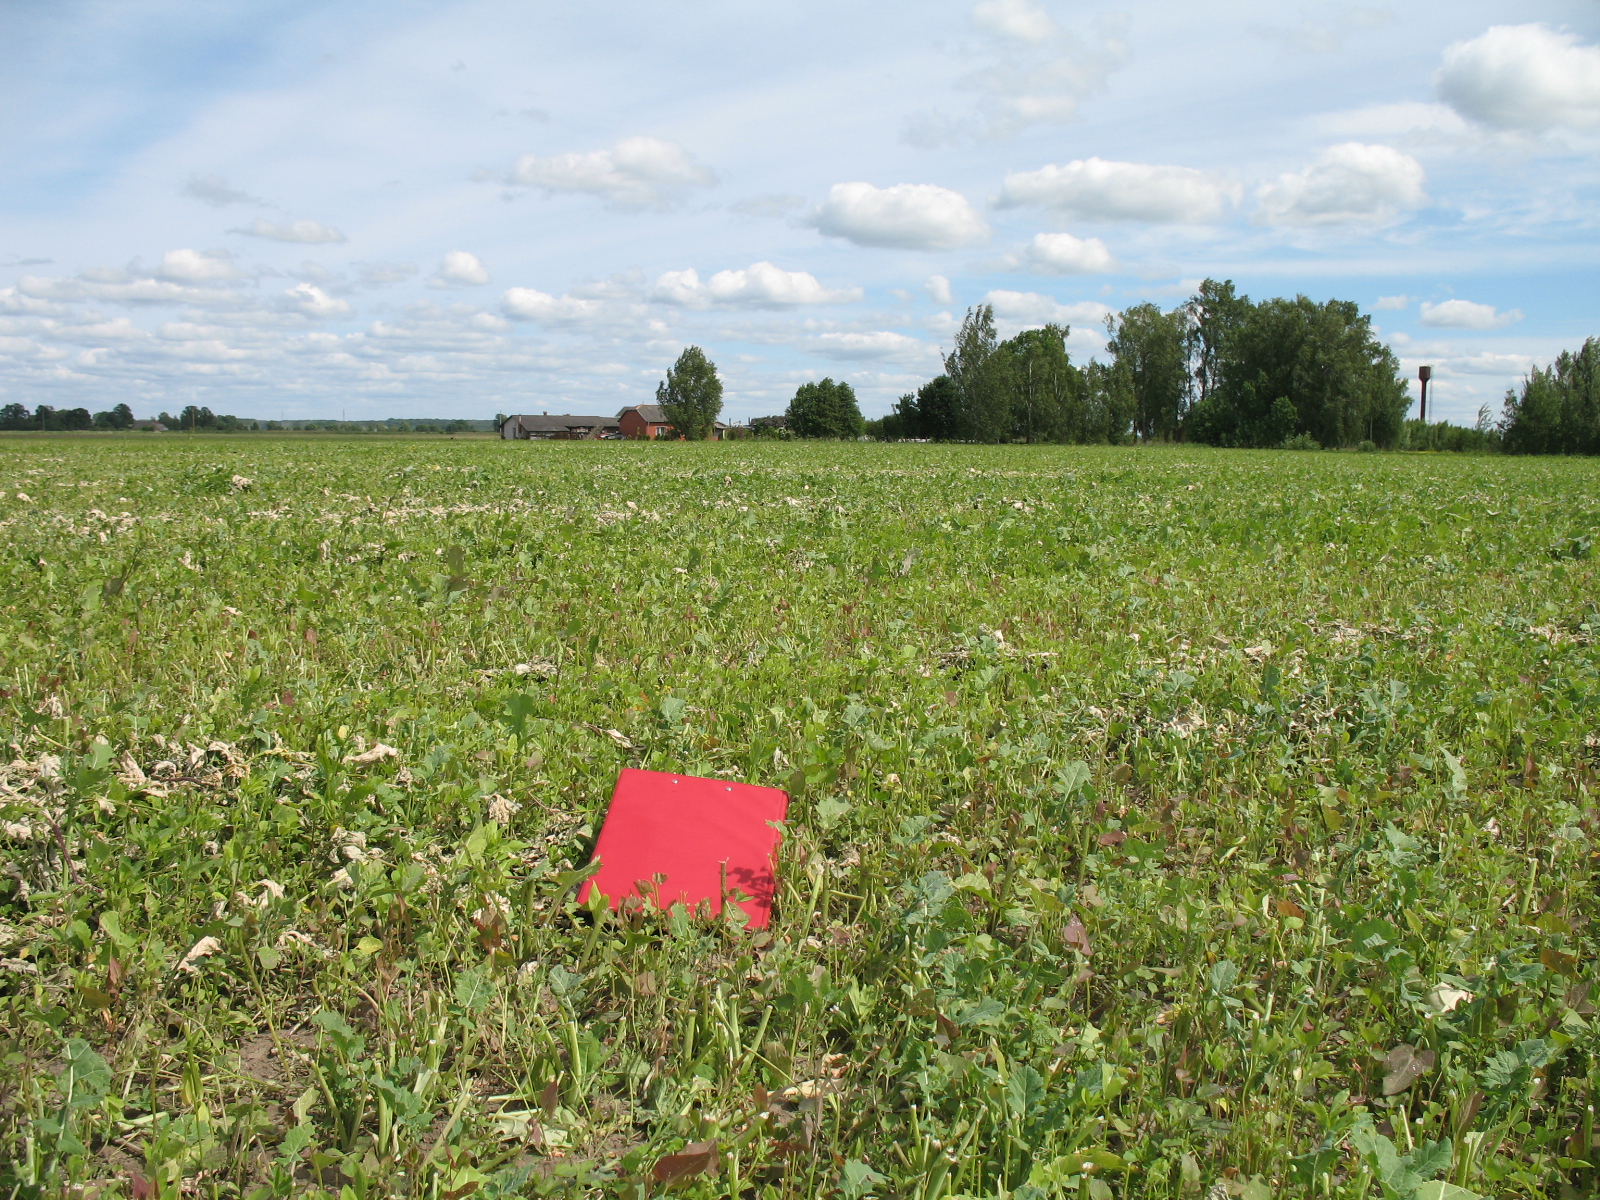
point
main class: Cropland
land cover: Rape and turnip rape
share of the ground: > 75 %
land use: Agriculture (excluding fallow land and kitchen gardens)
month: June
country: LV
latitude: 56.6428
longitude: 23.4615
